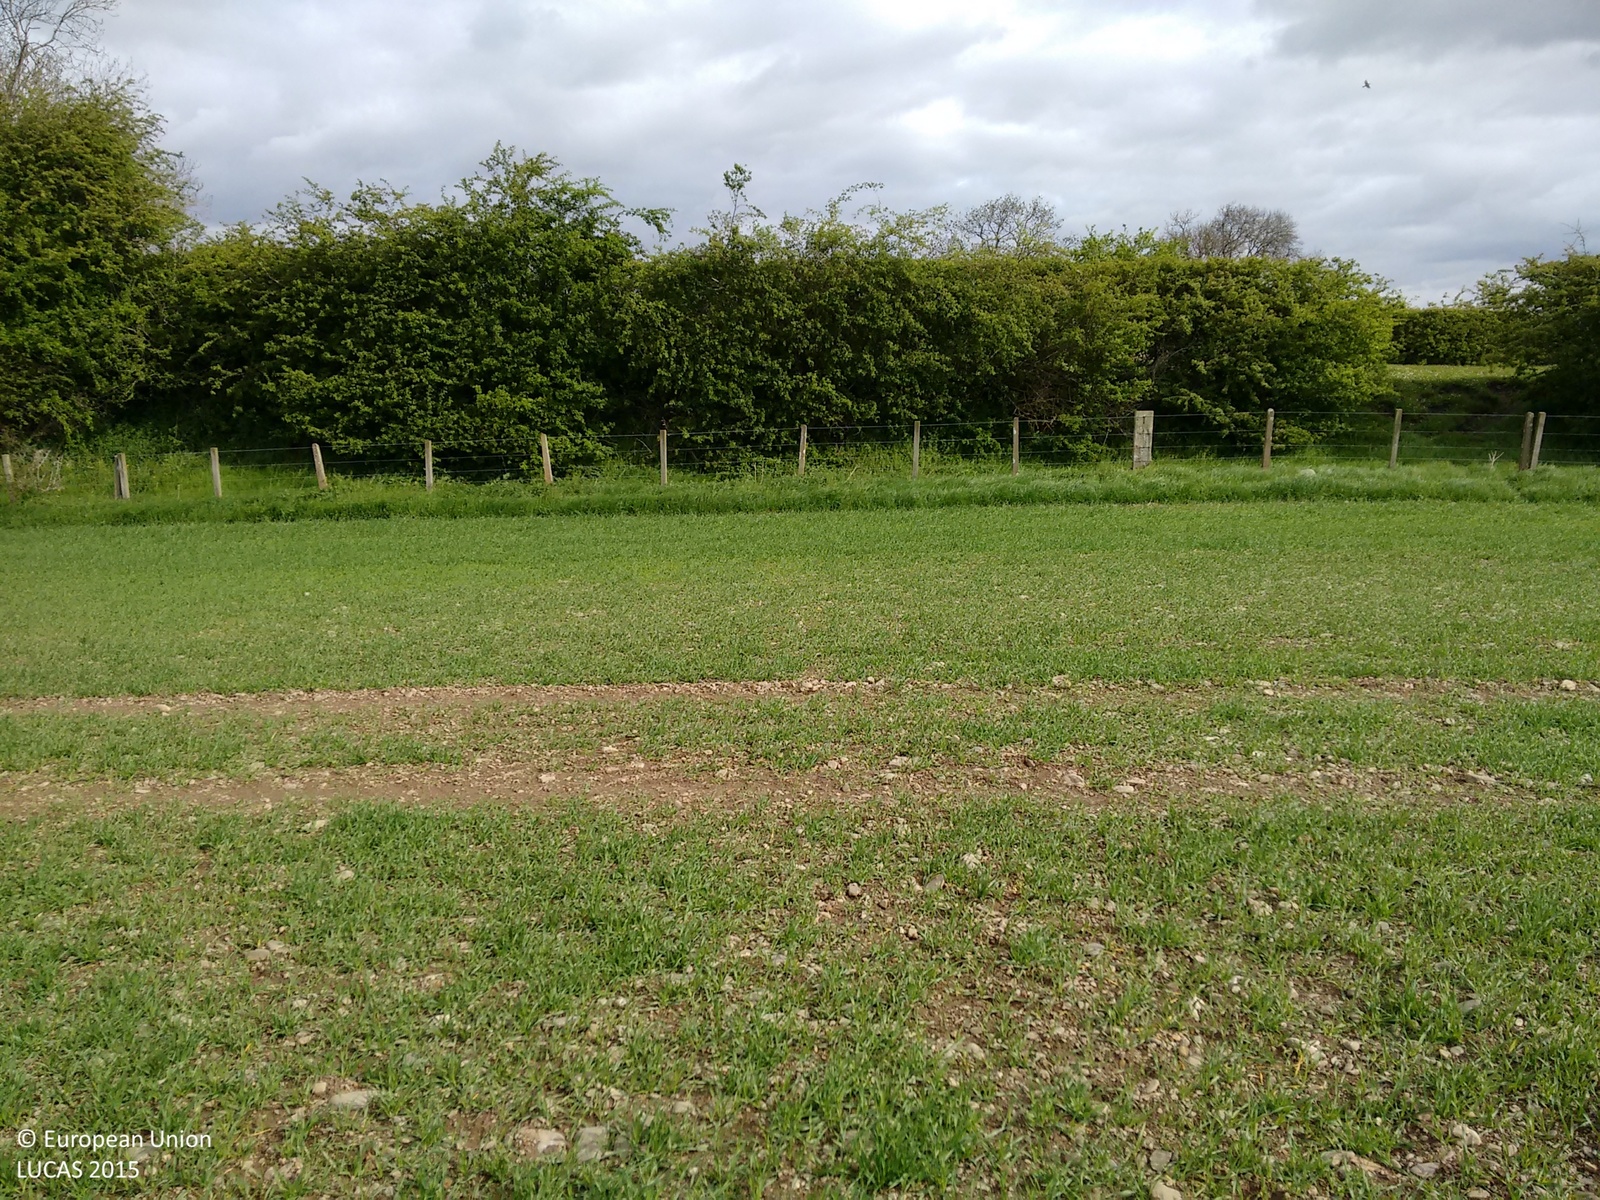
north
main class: Cropland
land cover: Barley
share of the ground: 50 - 75 %
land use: Agriculture (excluding fallow land and kitchen gardens)
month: May
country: GB
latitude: 55.5599
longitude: -2.6360
